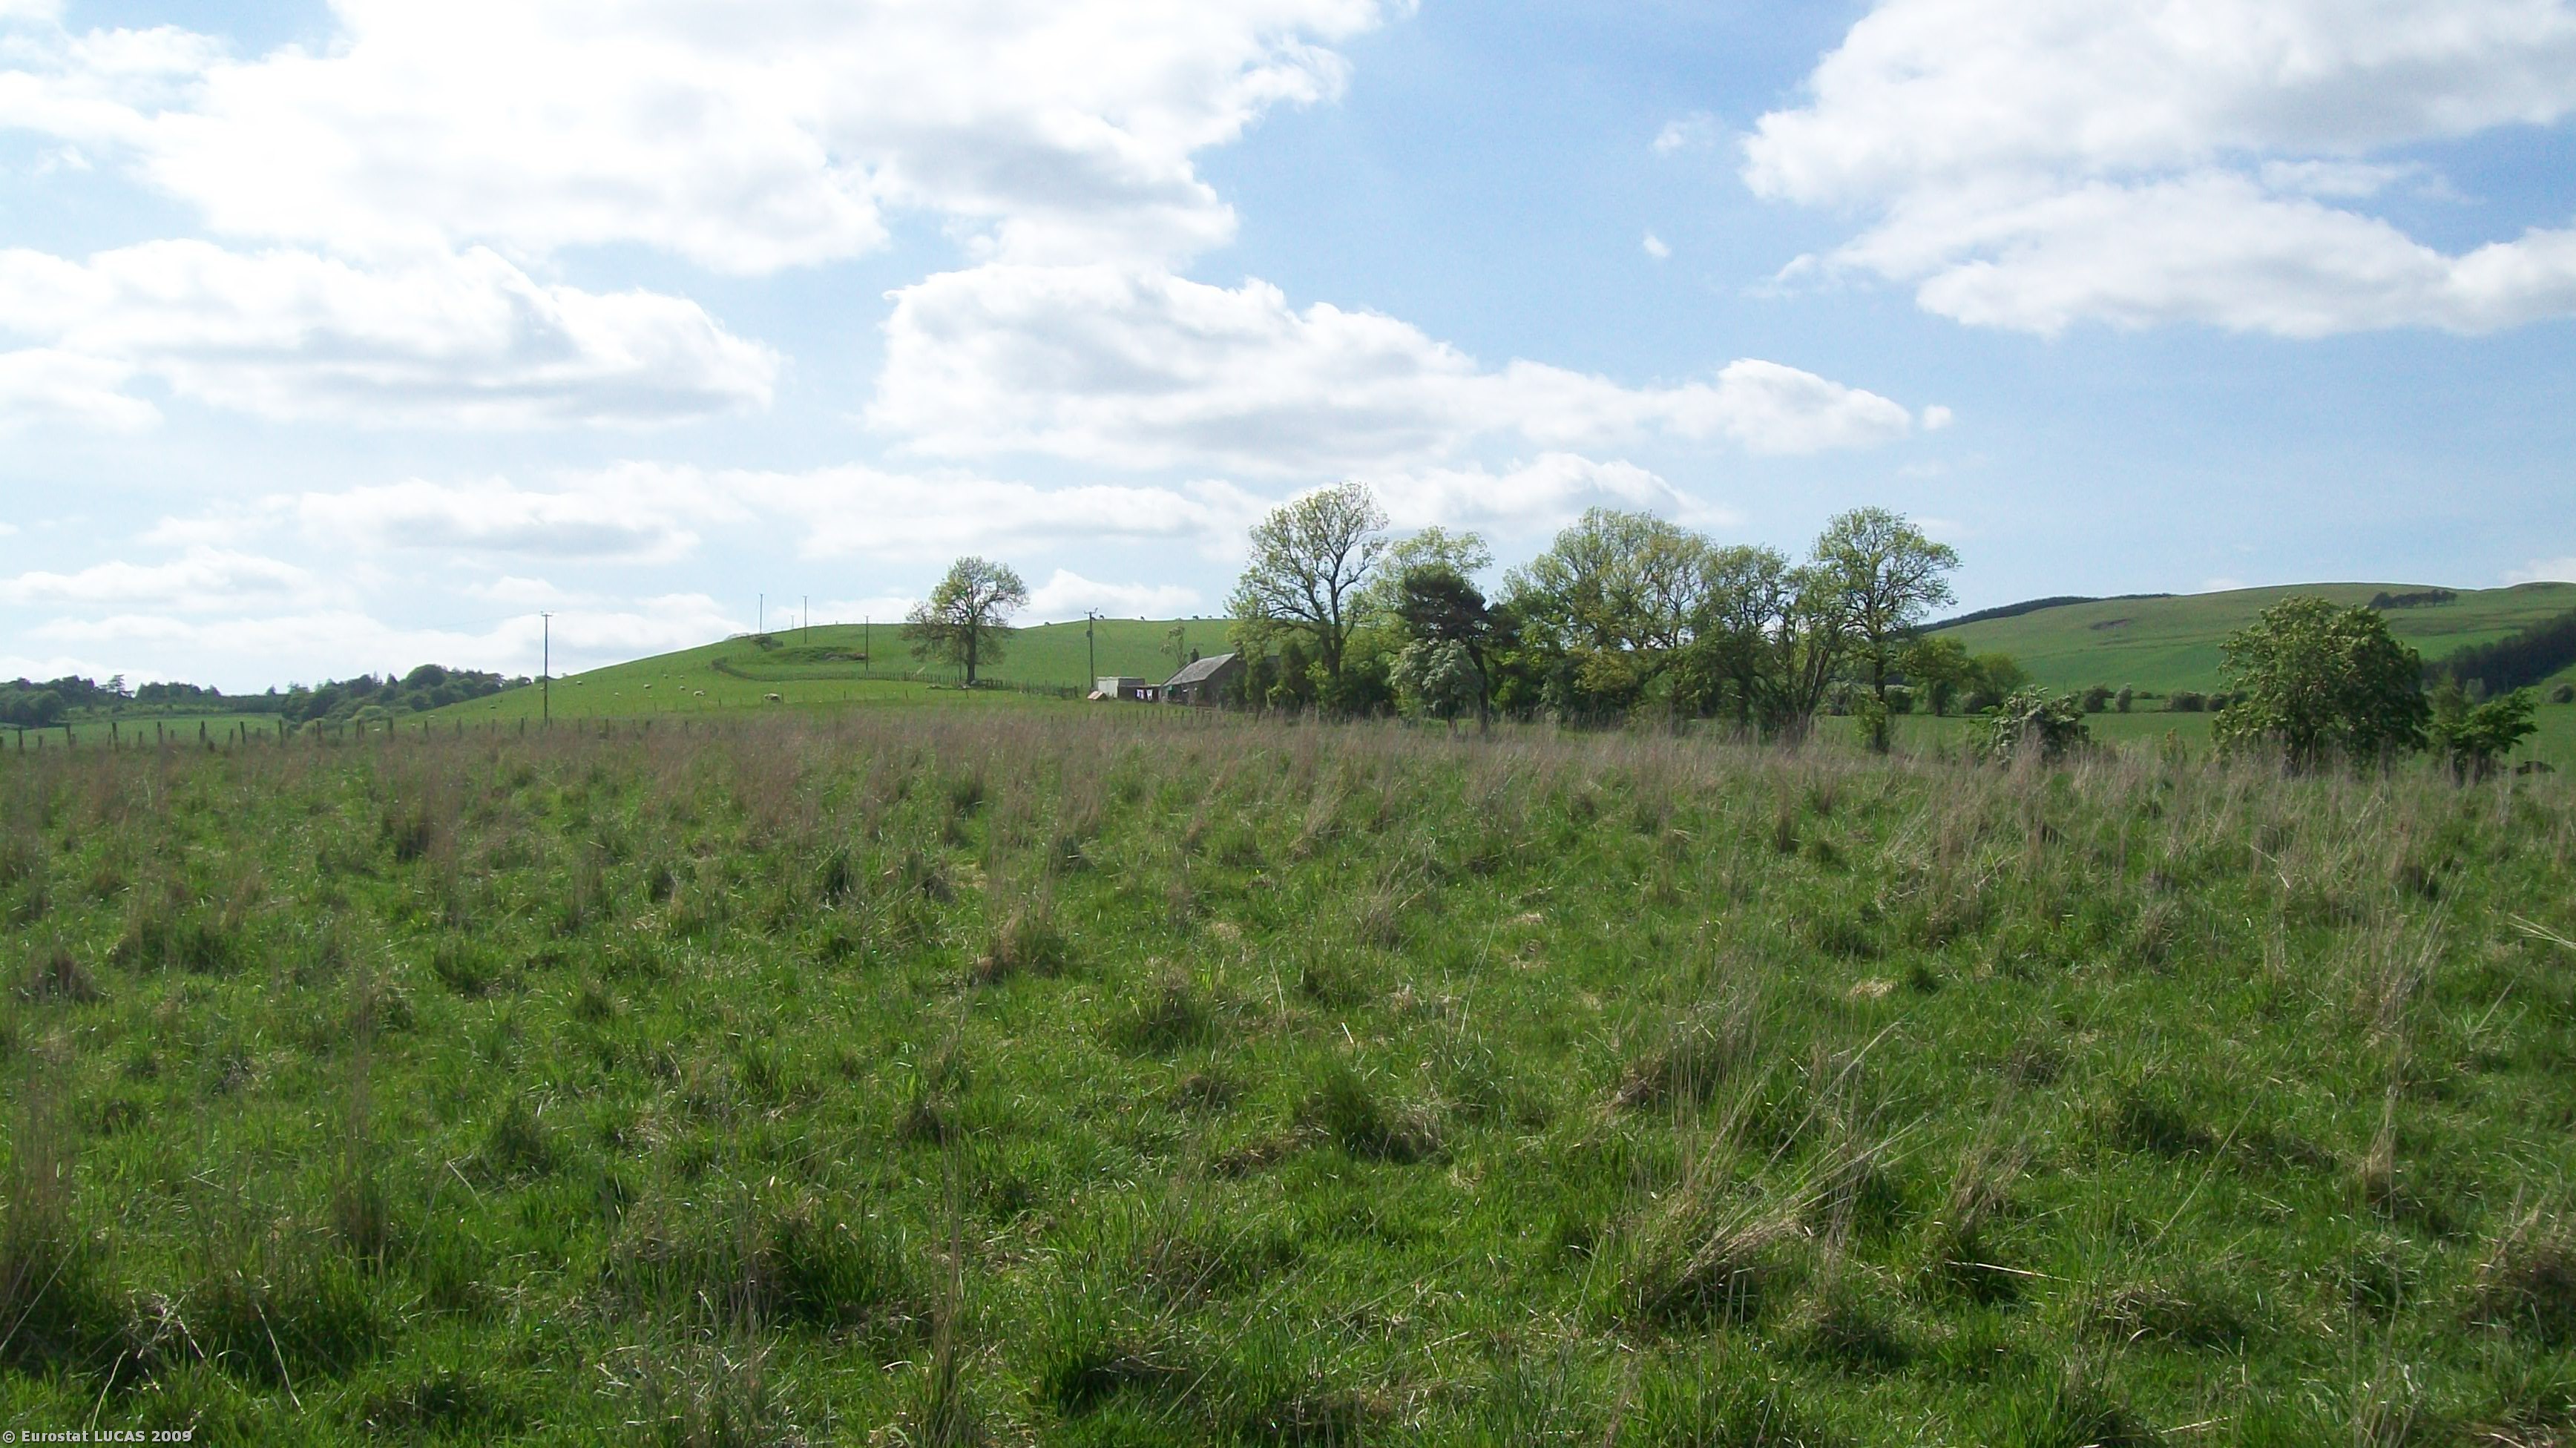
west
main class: Shrubland
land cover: Shrubland without tree cover
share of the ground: > 75 %
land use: Agriculture (excluding fallow land and kitchen gardens)
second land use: Forestry
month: June
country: GB
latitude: 55.6308
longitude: -3.5325
